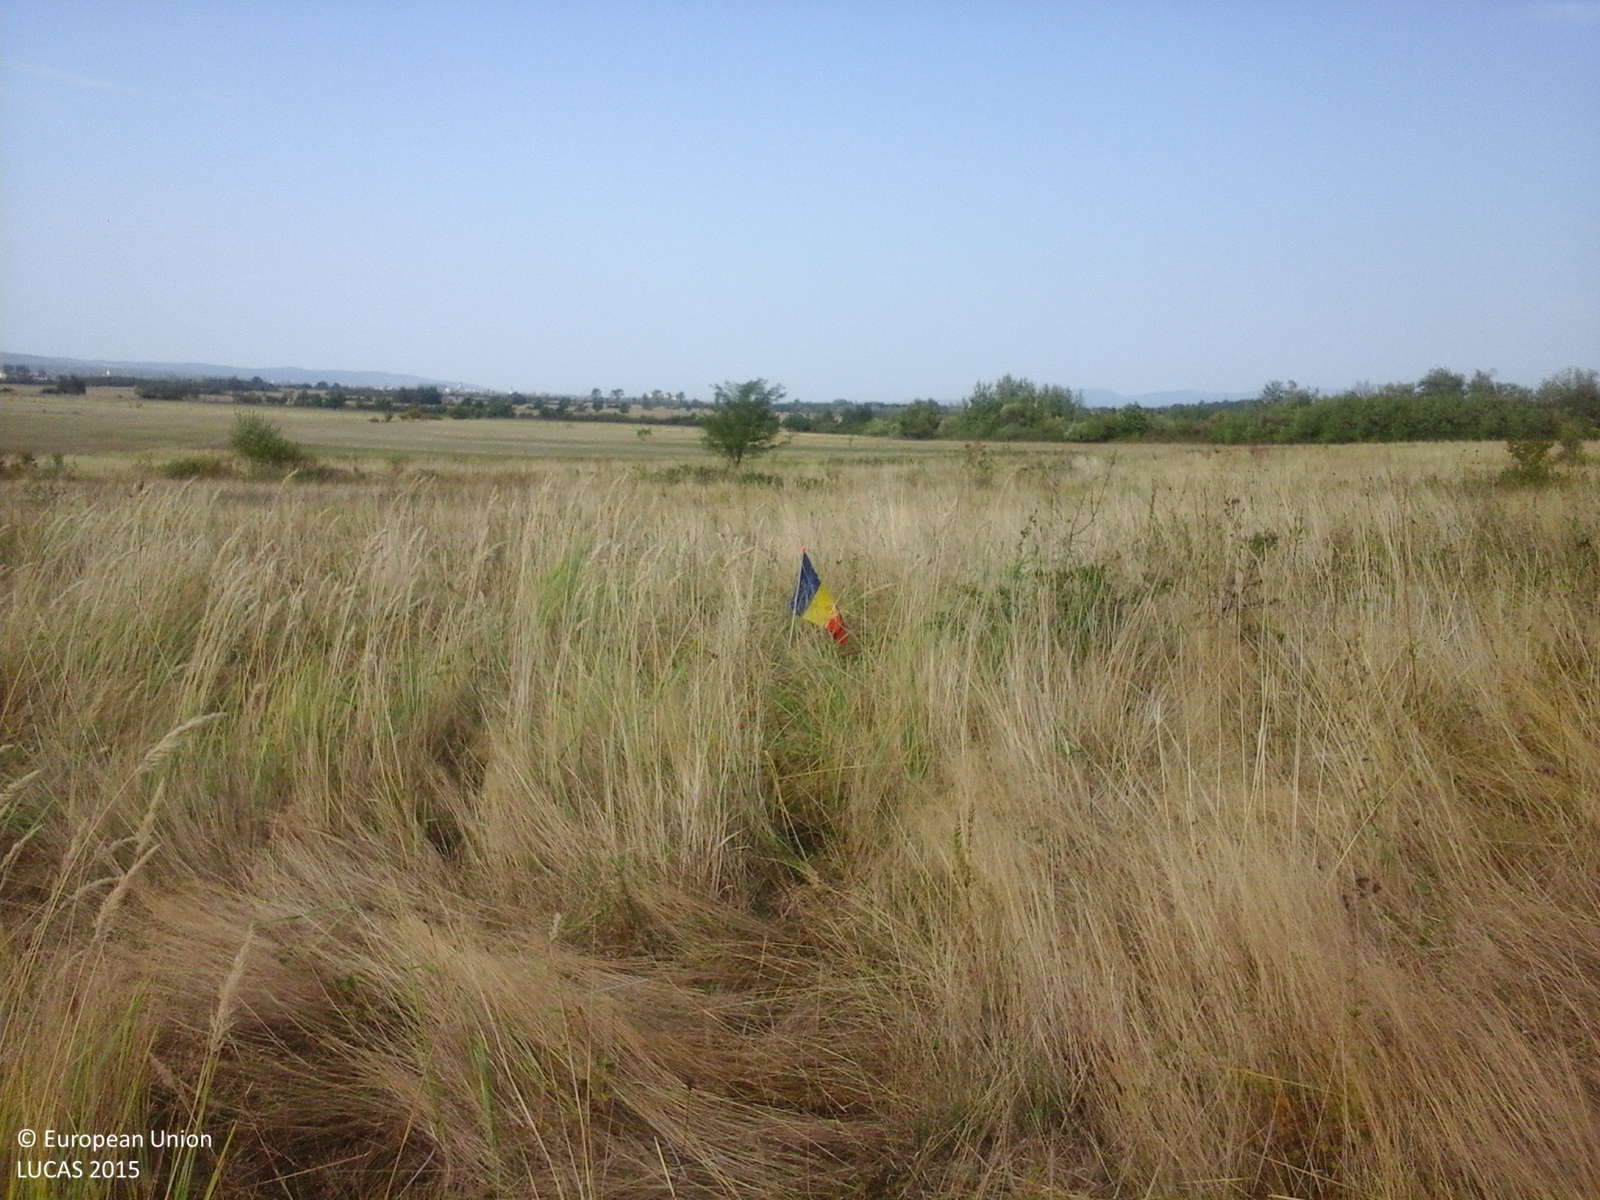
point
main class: Grassland
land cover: Grassland without tree/shrub cover
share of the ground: > 75 %
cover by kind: herbaceous plants 100 %
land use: Agriculture (excluding fallow land and kitchen gardens)
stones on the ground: < 10 %
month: September
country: RO
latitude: 45.3697
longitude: 22.2603
